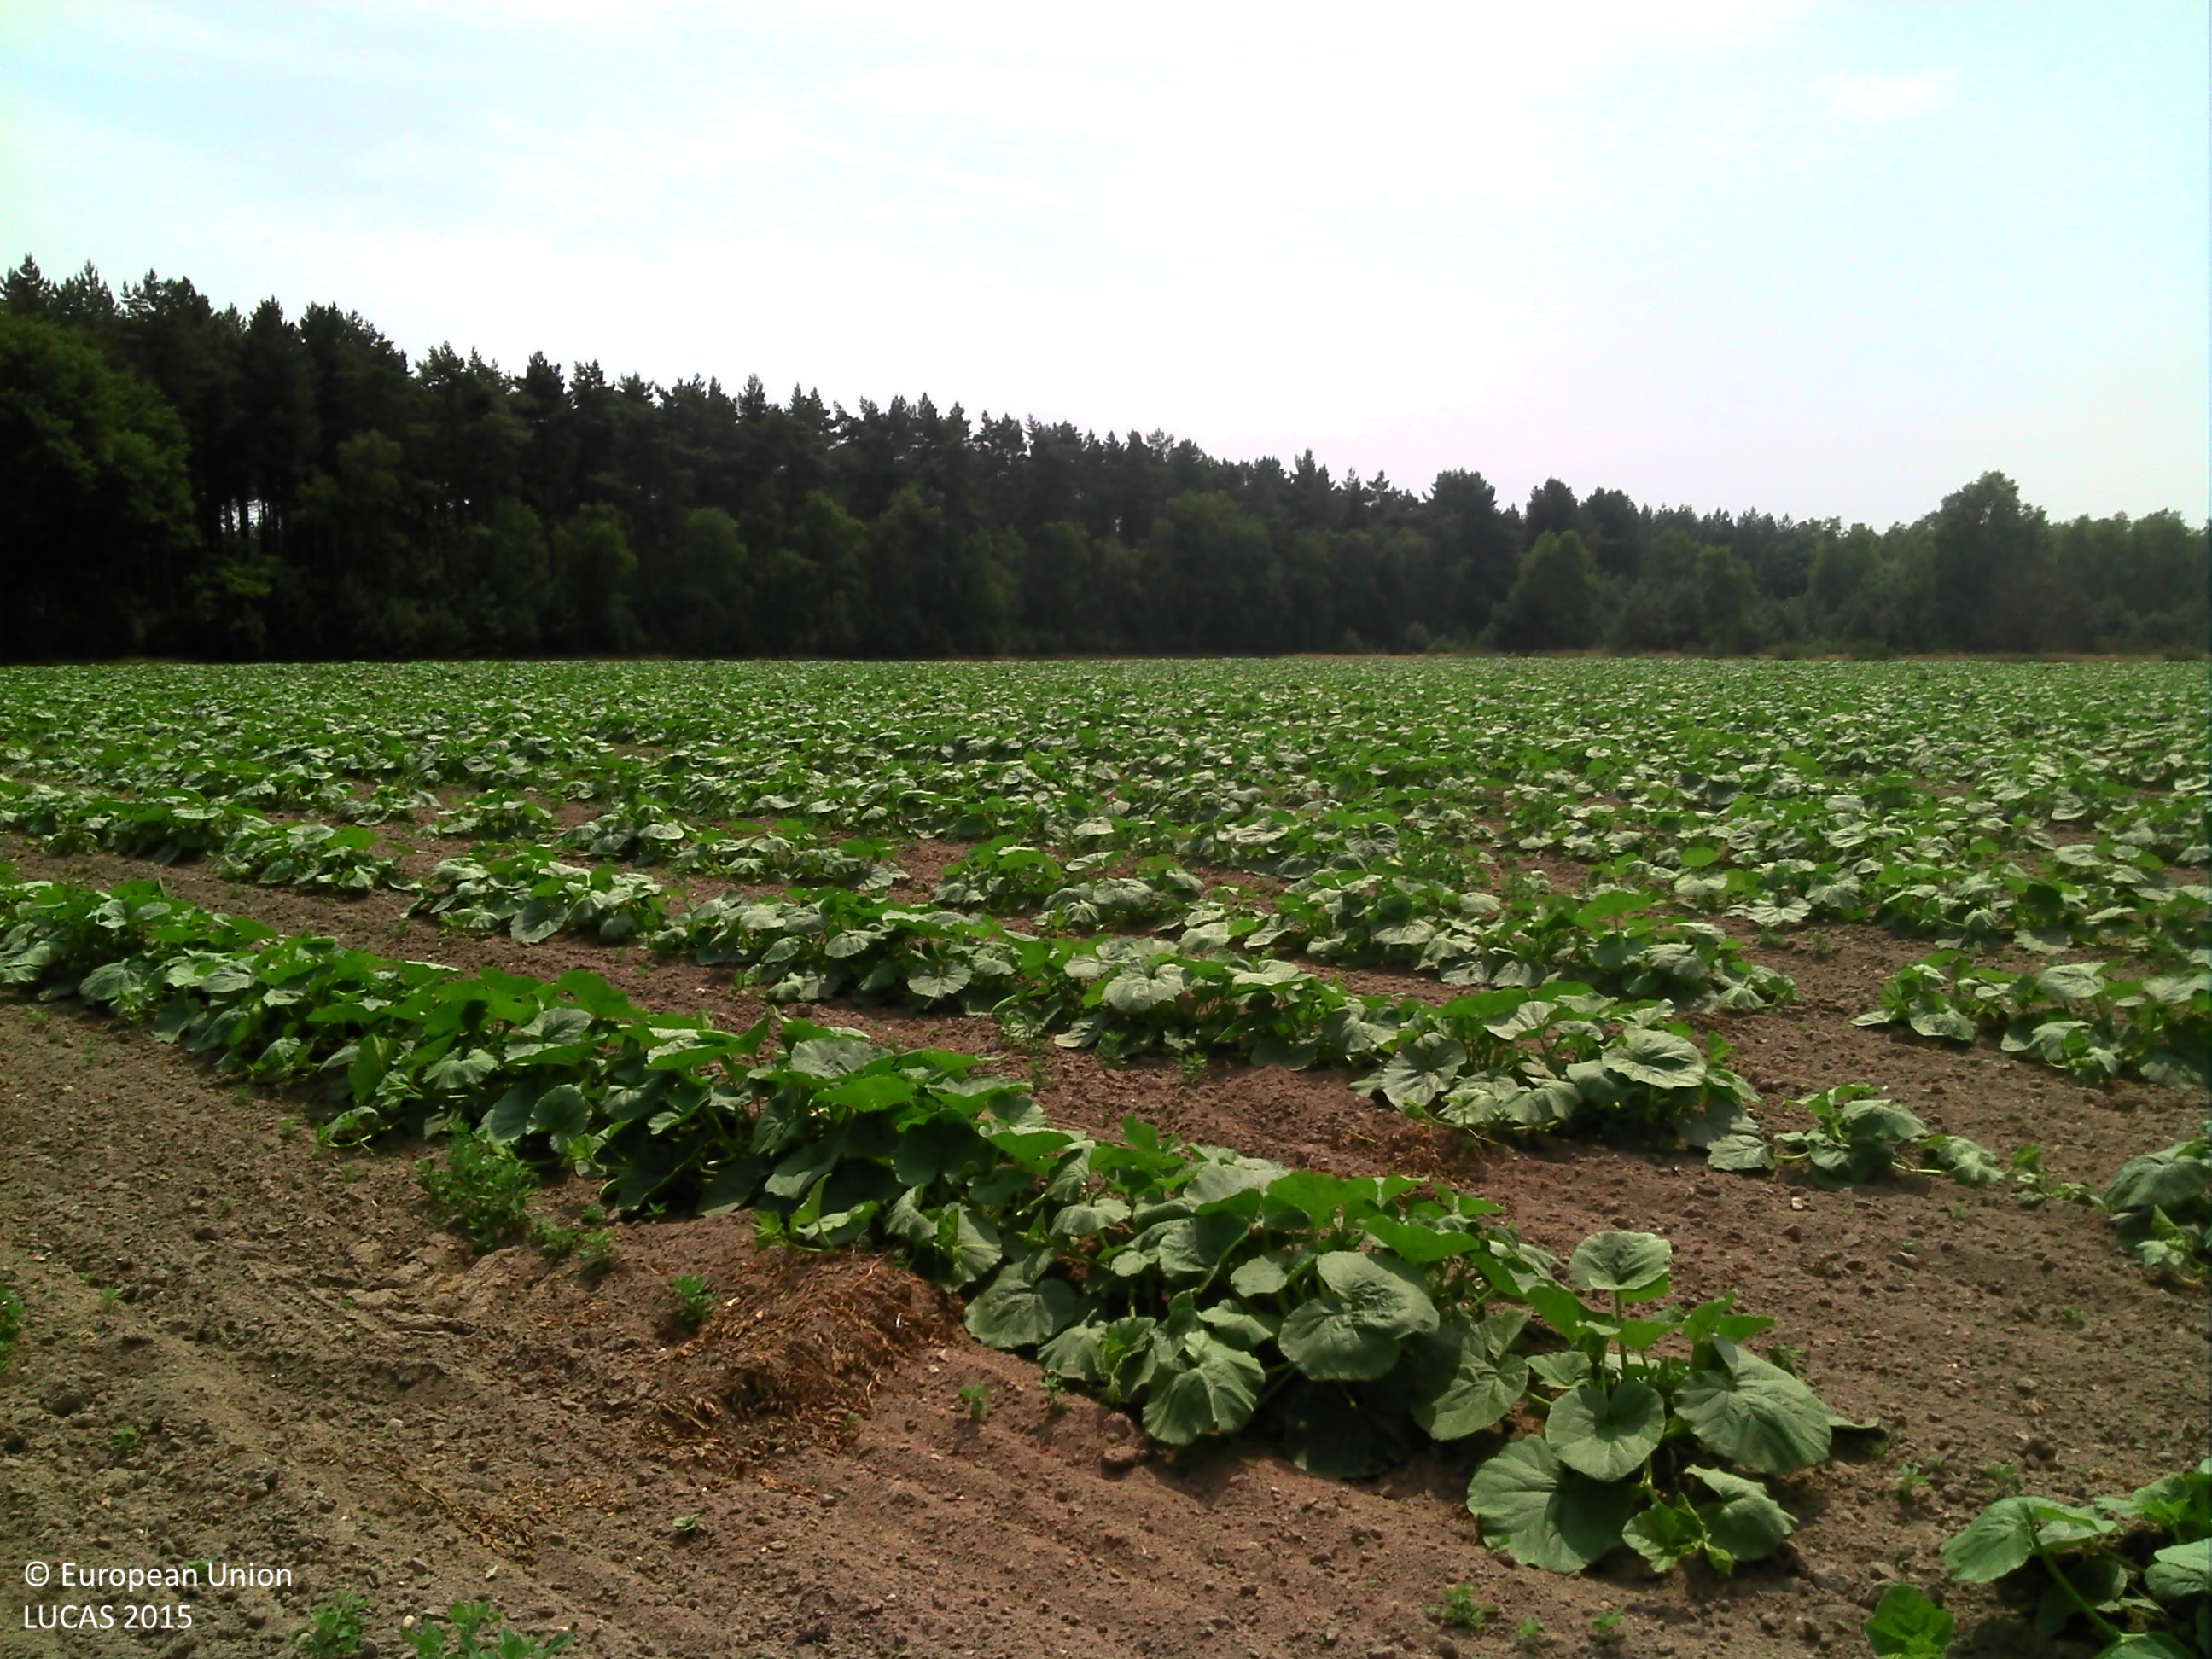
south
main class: Cropland
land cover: Other fresh vegetables
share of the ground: 10 - 25 %
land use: Agriculture (excluding fallow land and kitchen gardens)
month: July
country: BE
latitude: 51.0512
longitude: 5.5331
